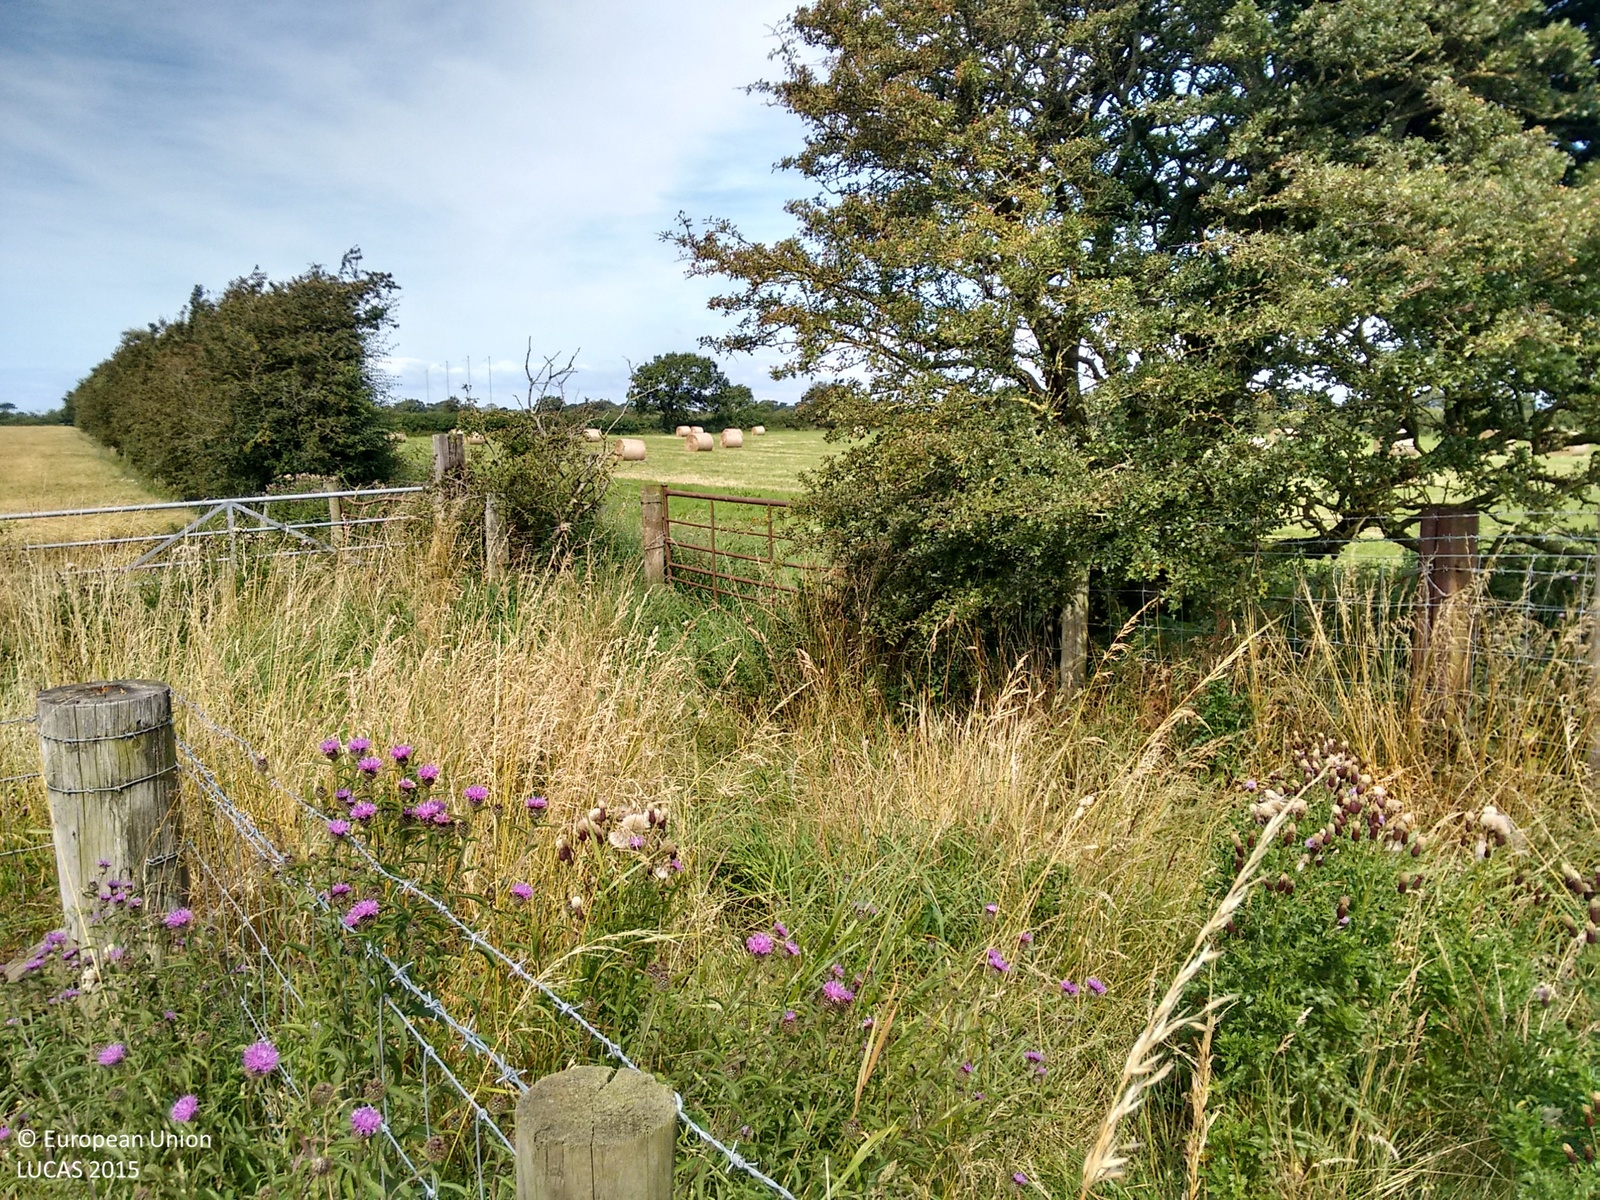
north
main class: Cropland
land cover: Barley
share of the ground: > 75 %
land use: Agriculture (excluding fallow land and kitchen gardens)
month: August
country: GB
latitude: 54.8767
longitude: -3.2456
